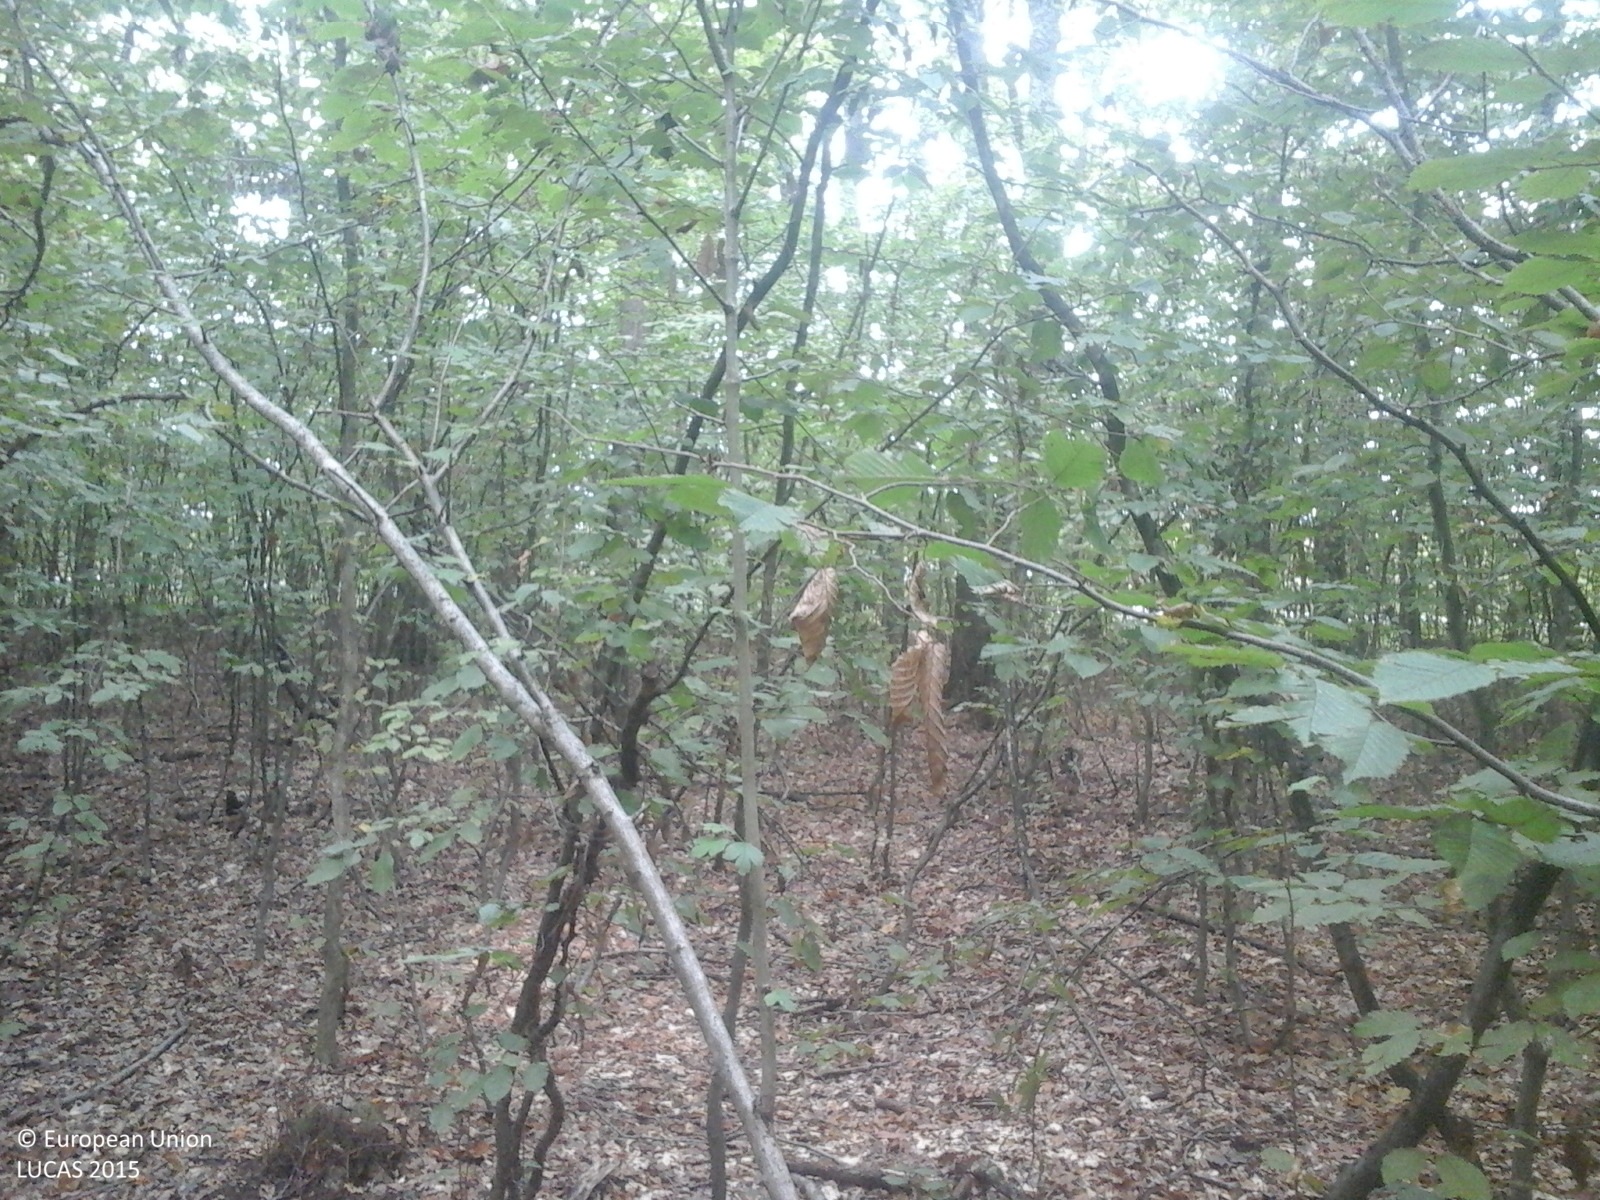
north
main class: Woodland
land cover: Broadleaved woodland
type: acidophilous oak and oak-birch forest
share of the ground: > 75 %
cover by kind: broadleaved forest trees 100 %
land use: Forestry
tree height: > 5 m
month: October
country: RO
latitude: 46.3301
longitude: 23.6436
